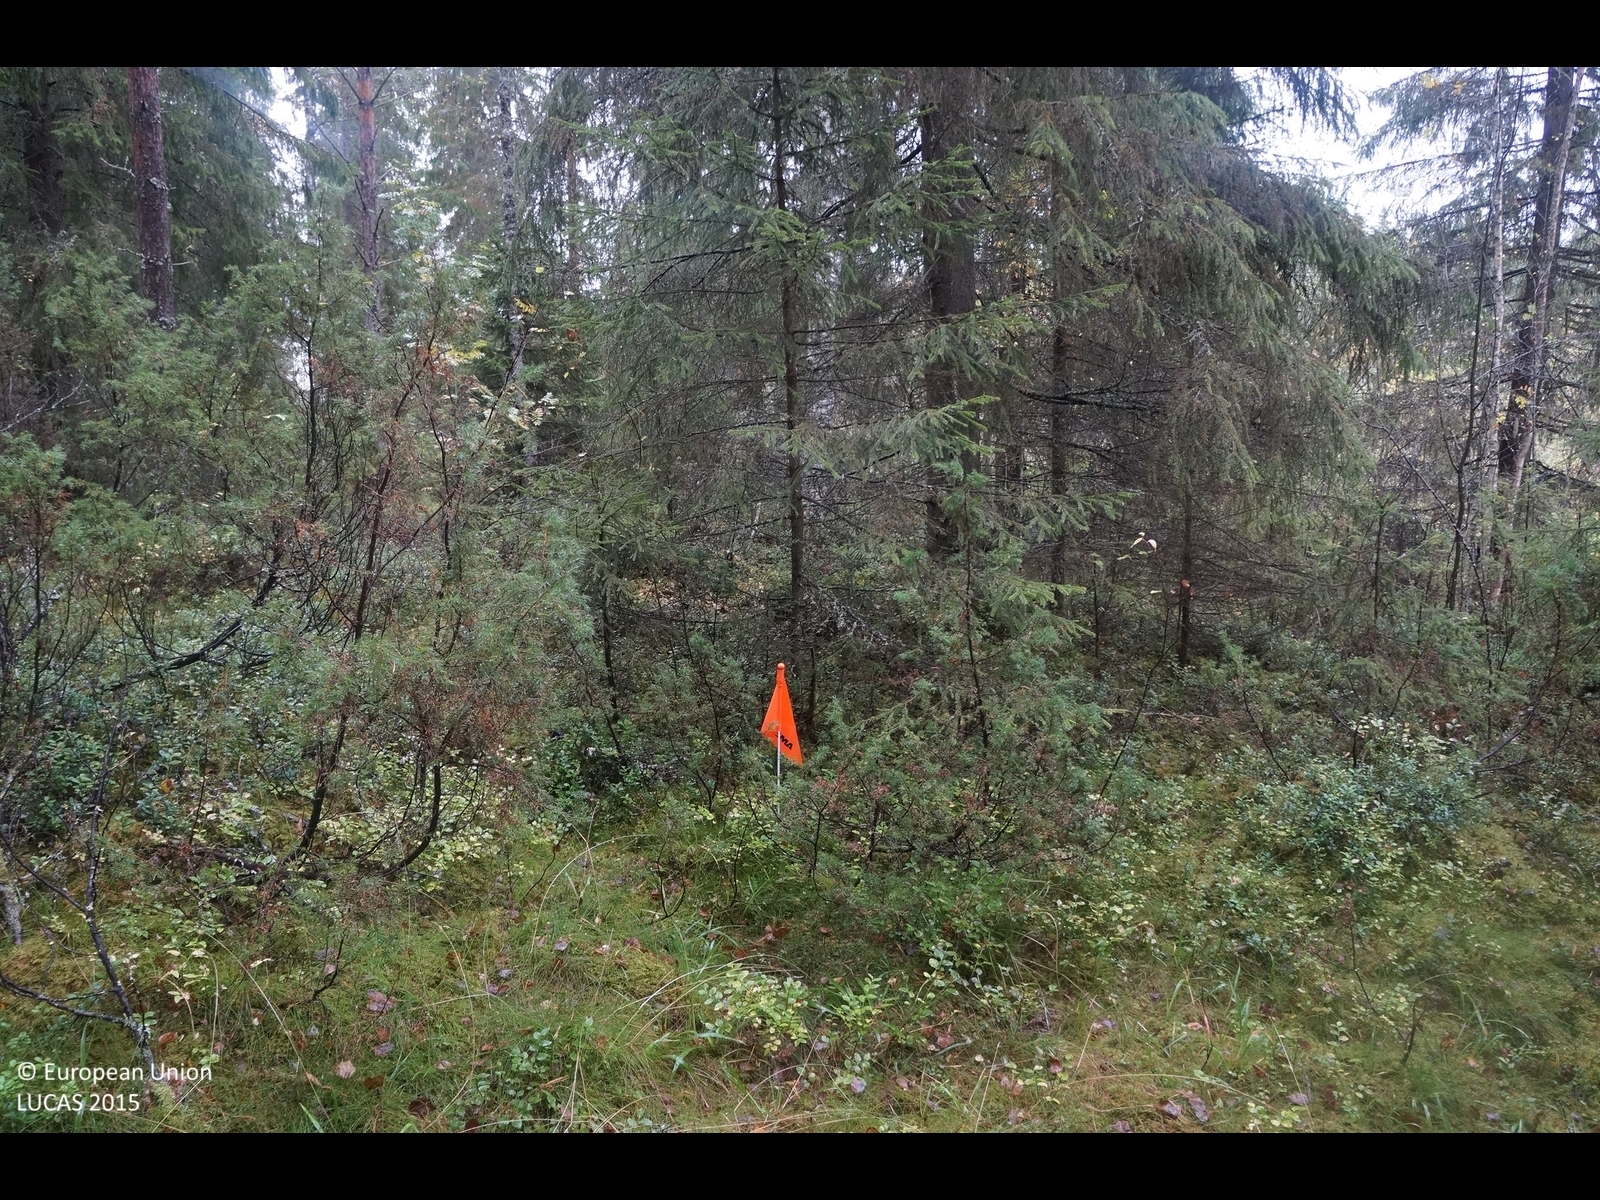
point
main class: Woodland
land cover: Spruce dominated coniferous woodland
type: boreal forest
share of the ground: 50 - 75 %
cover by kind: coniferous forest trees 60 %, shrubs 15 %, lichens and mosses 15 %, herbaceous plants 10 %
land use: Forestry
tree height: > 5 m
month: September
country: FI
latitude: 64.0574
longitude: 24.5183
